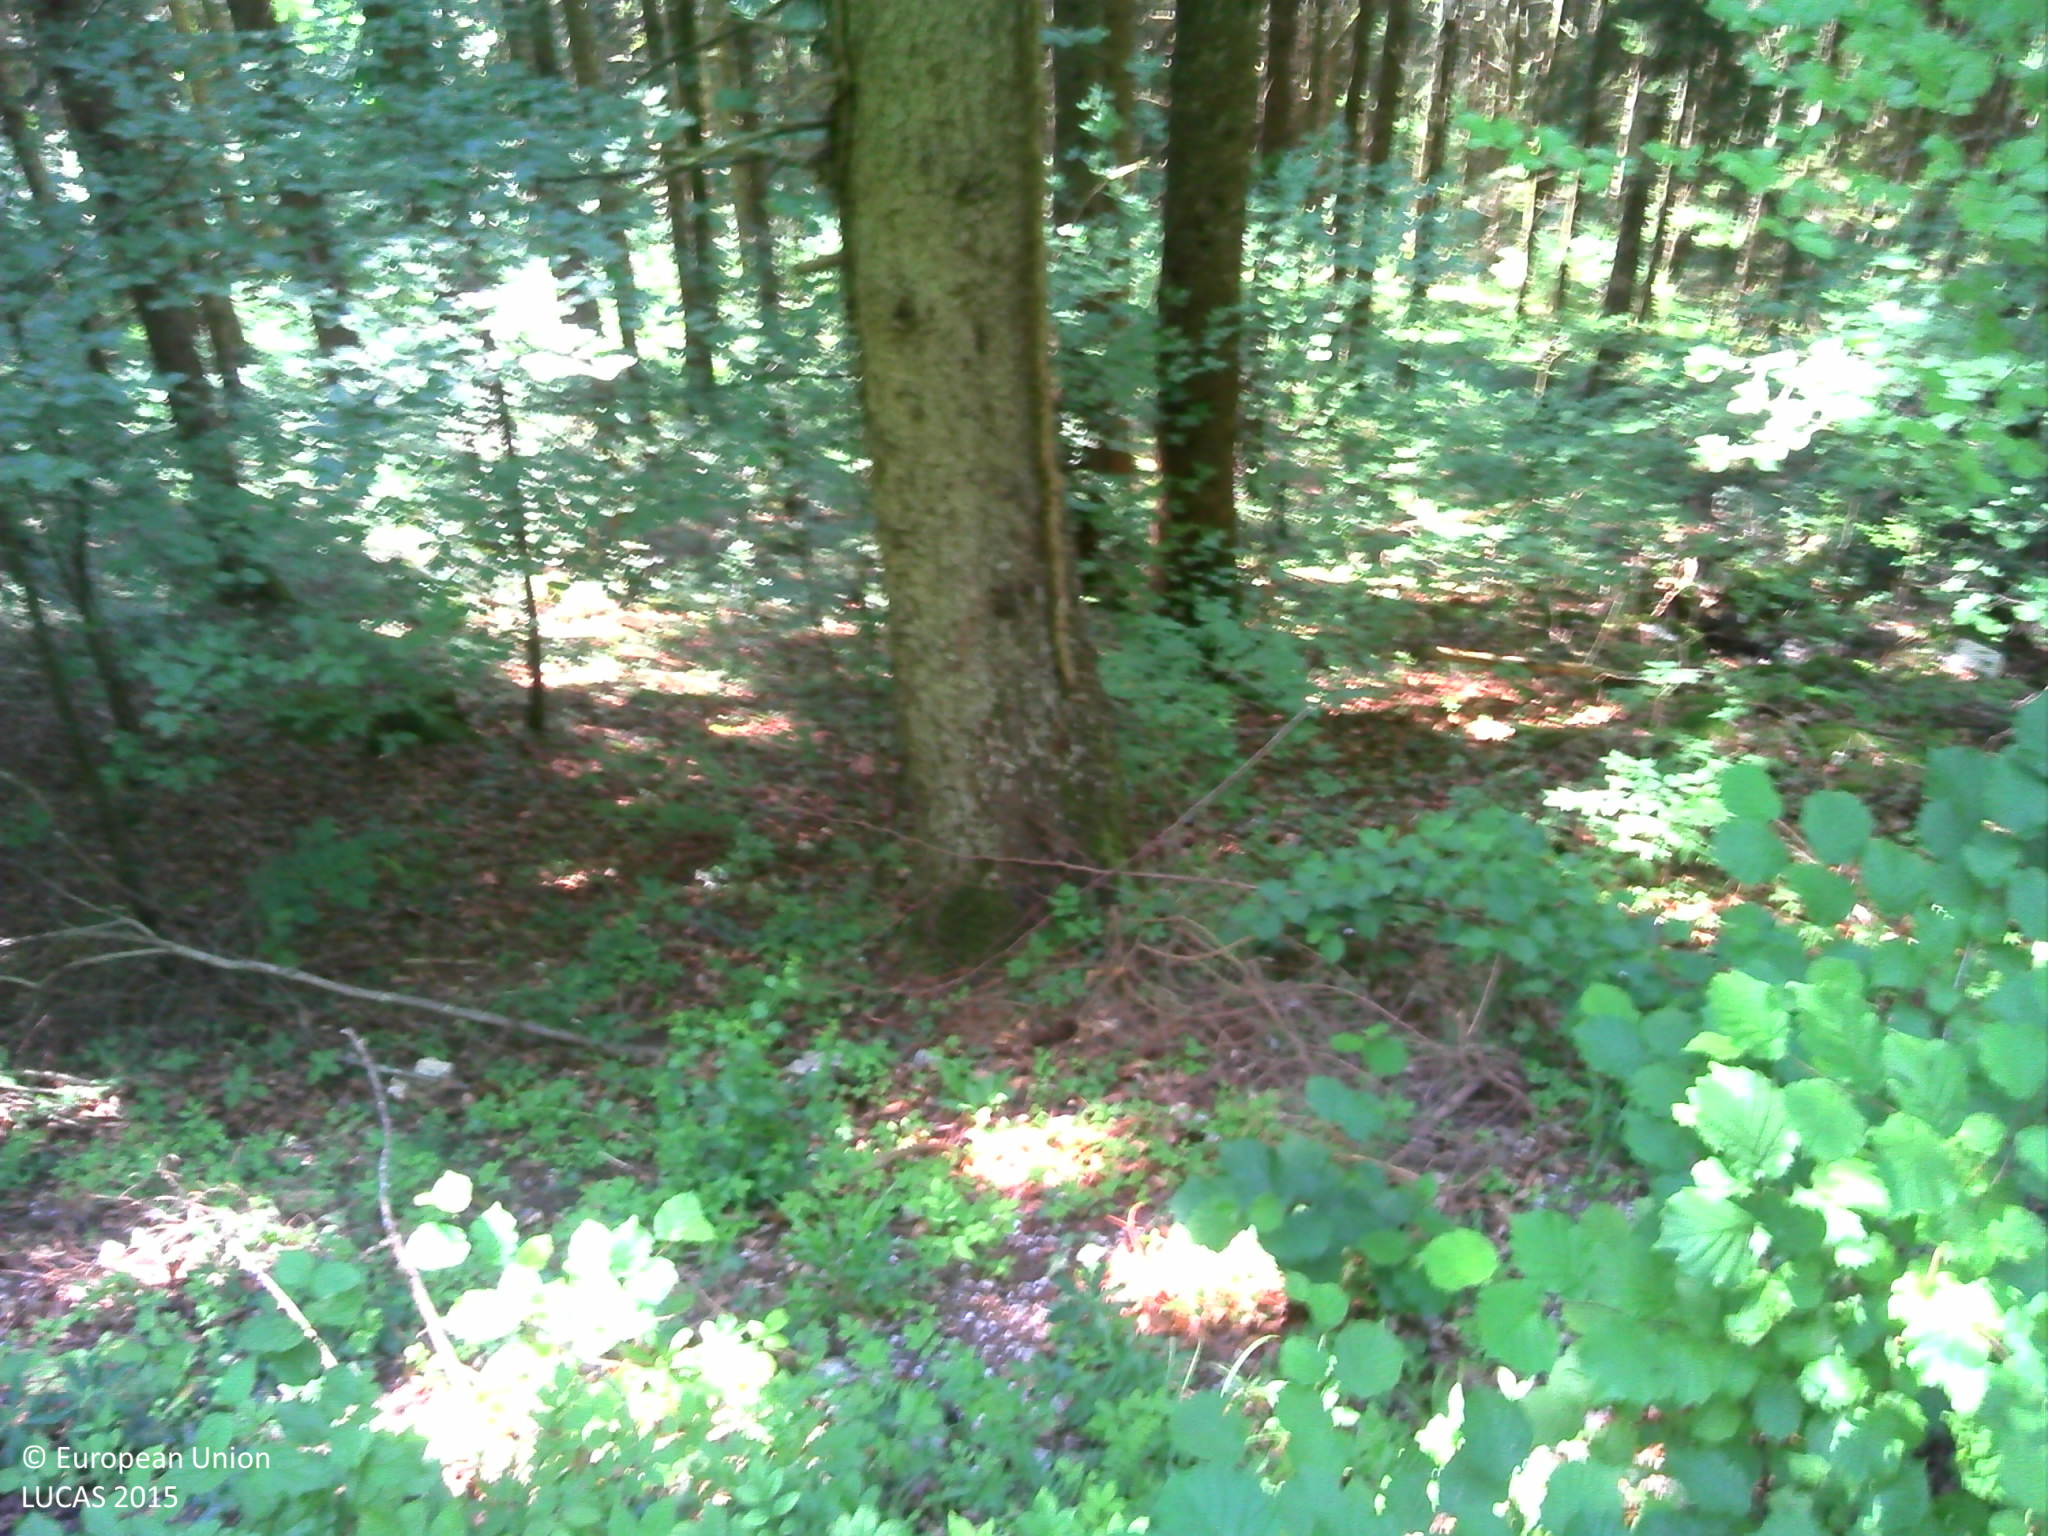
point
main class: Woodland
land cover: Spruce dominated coniferous woodland
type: hemiboreal forest and nemoral coniferous forest and mixed broadleaved-coniferous forest
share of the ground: > 75 %
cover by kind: coniferous forest trees 95 %, unconsolidated bare surface 5 %
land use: Forestry
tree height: > 5 m
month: June
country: FR
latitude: 45.0823
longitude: 5.4702
